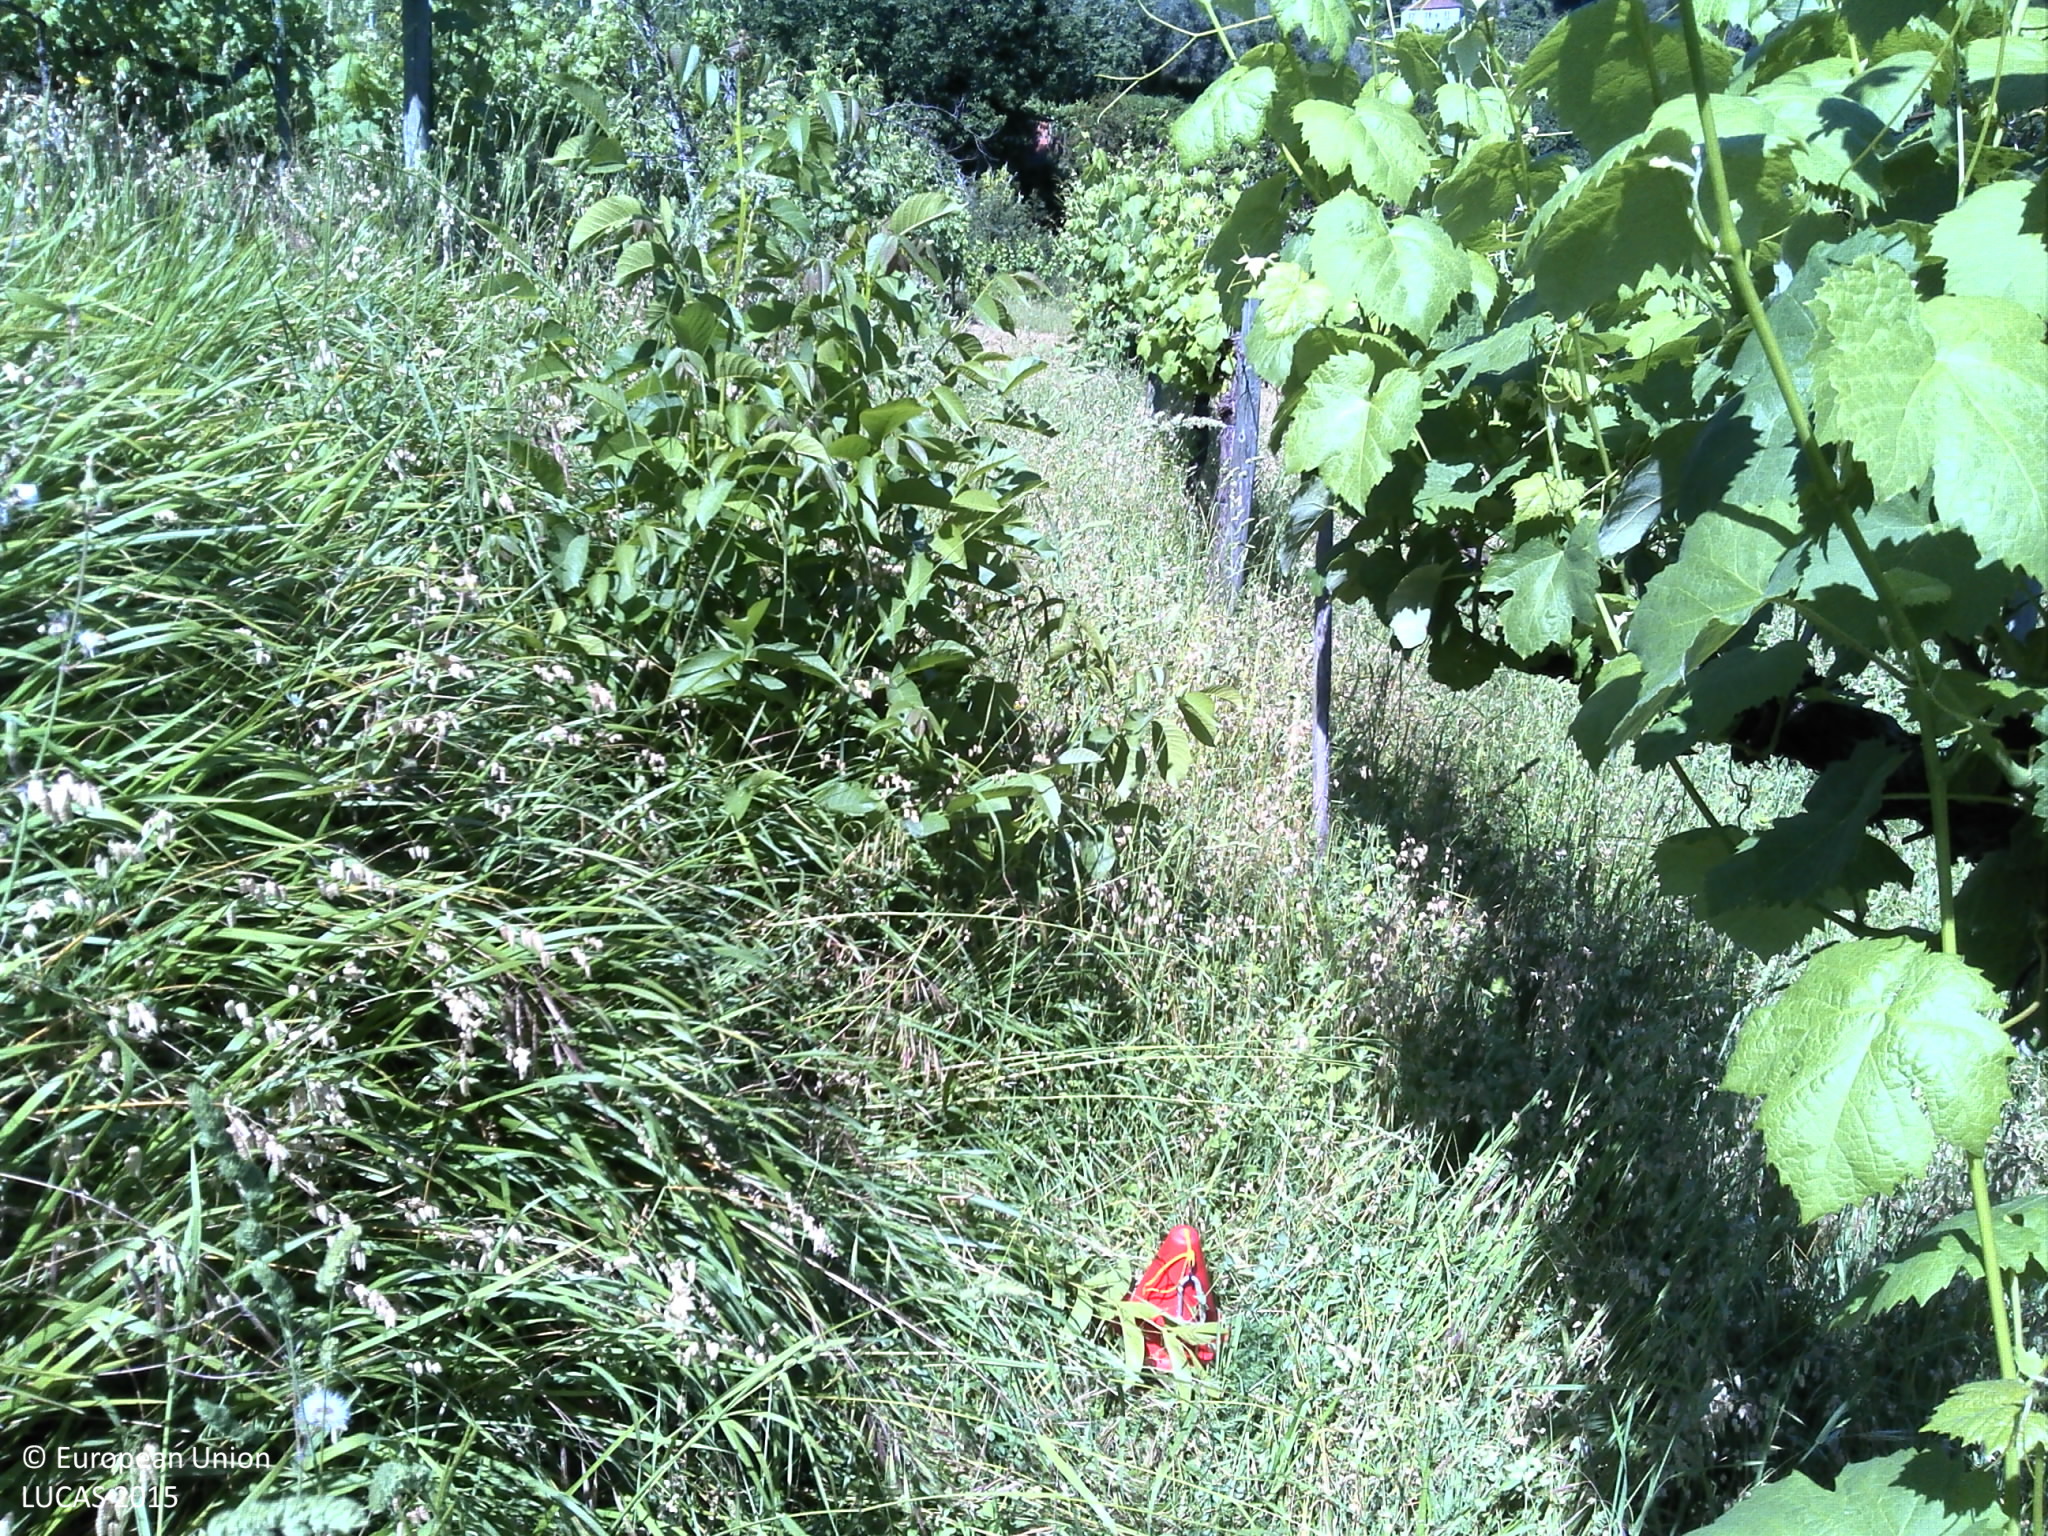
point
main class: Cropland
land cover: Vineyards
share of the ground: 10 - 25 %
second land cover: Grassland without tree/shrub cover
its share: 50 - 75 %
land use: Agriculture (excluding fallow land and kitchen gardens)
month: June
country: PT
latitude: 41.8419
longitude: -8.3783
